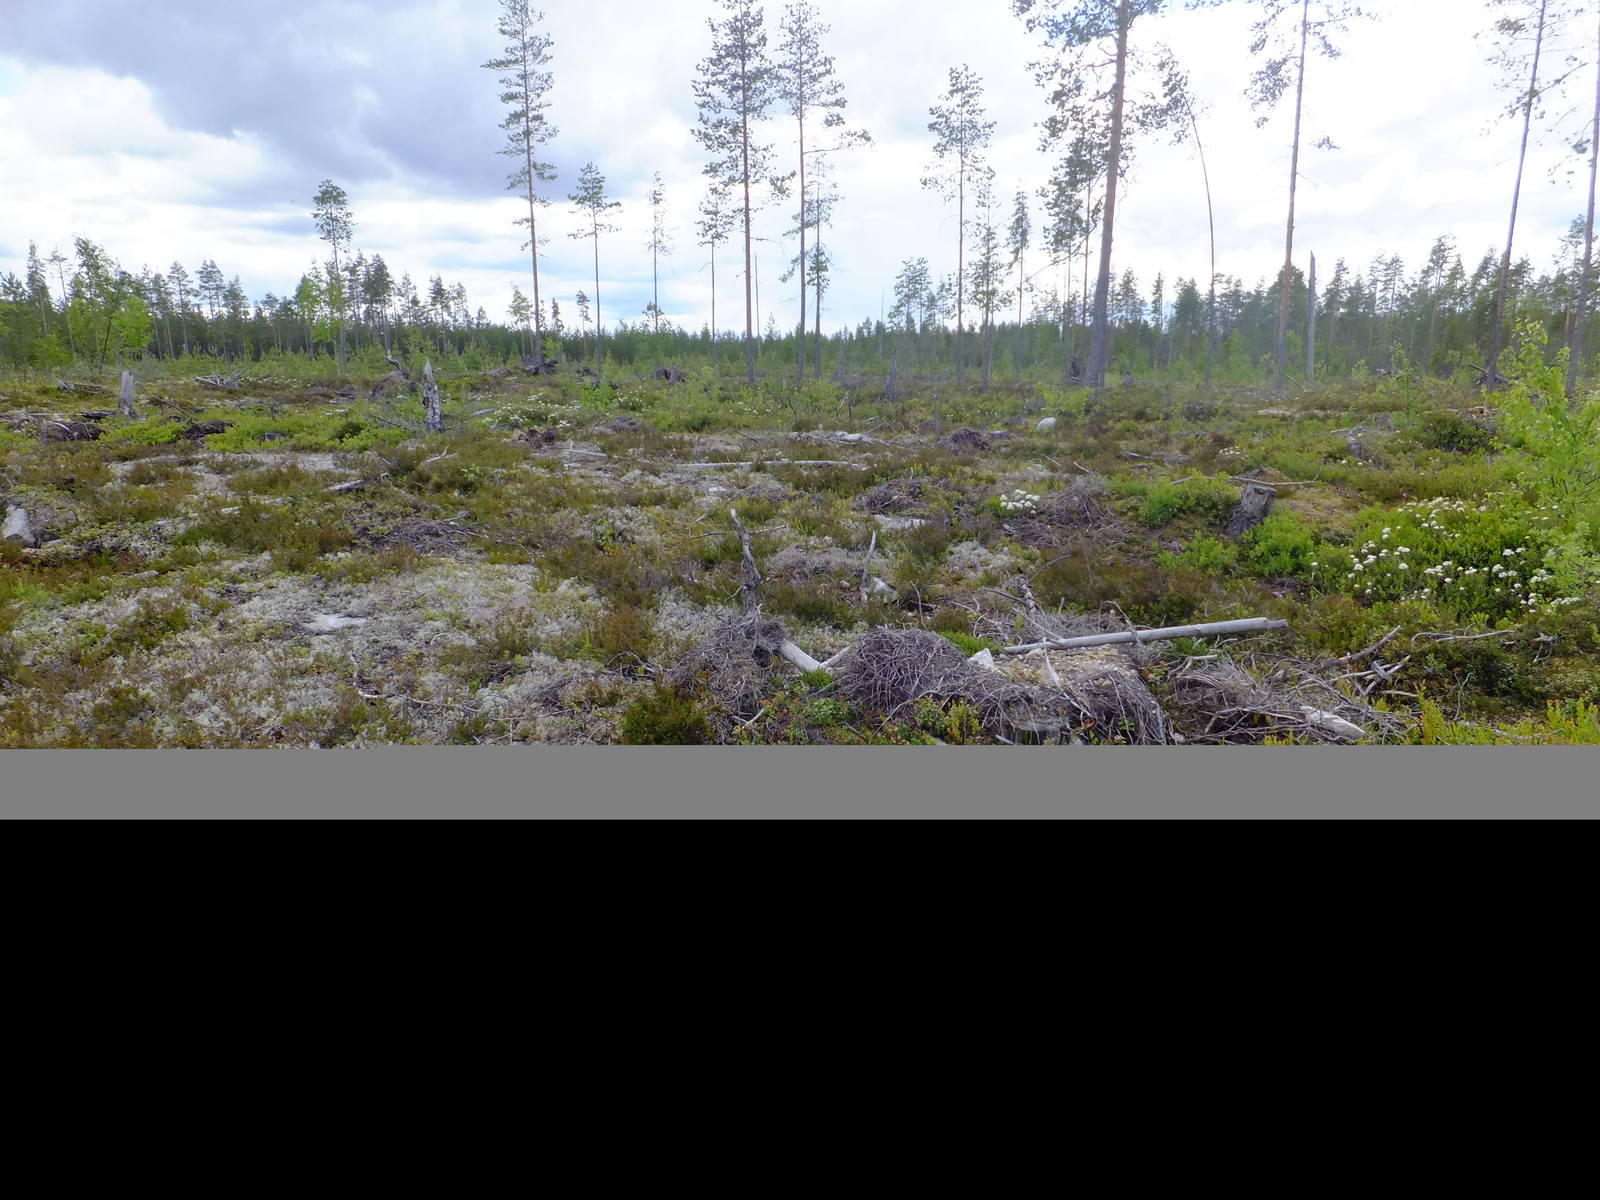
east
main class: Shrubland
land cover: Shrubland with sparse tree cover
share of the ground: 50 - 75 %
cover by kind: shrubs 55 %, lichens and mosses 20 %, consolidated bare surface 20 %, broadleaved forest trees 5 %
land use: Forestry
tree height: > 5 m
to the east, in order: Shrubland with sparse tree cover; Pine dominated coniferous woodland; Pine dominated mixed woodland; Lichens and moss; Pine dominated coniferous woodland; Tracks; Shrubland without tree cover; Shrubland with sparse tree cover; Ditches and canals; Broadleaved woodland
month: June
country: FI
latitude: 63.4876
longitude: 24.8863
